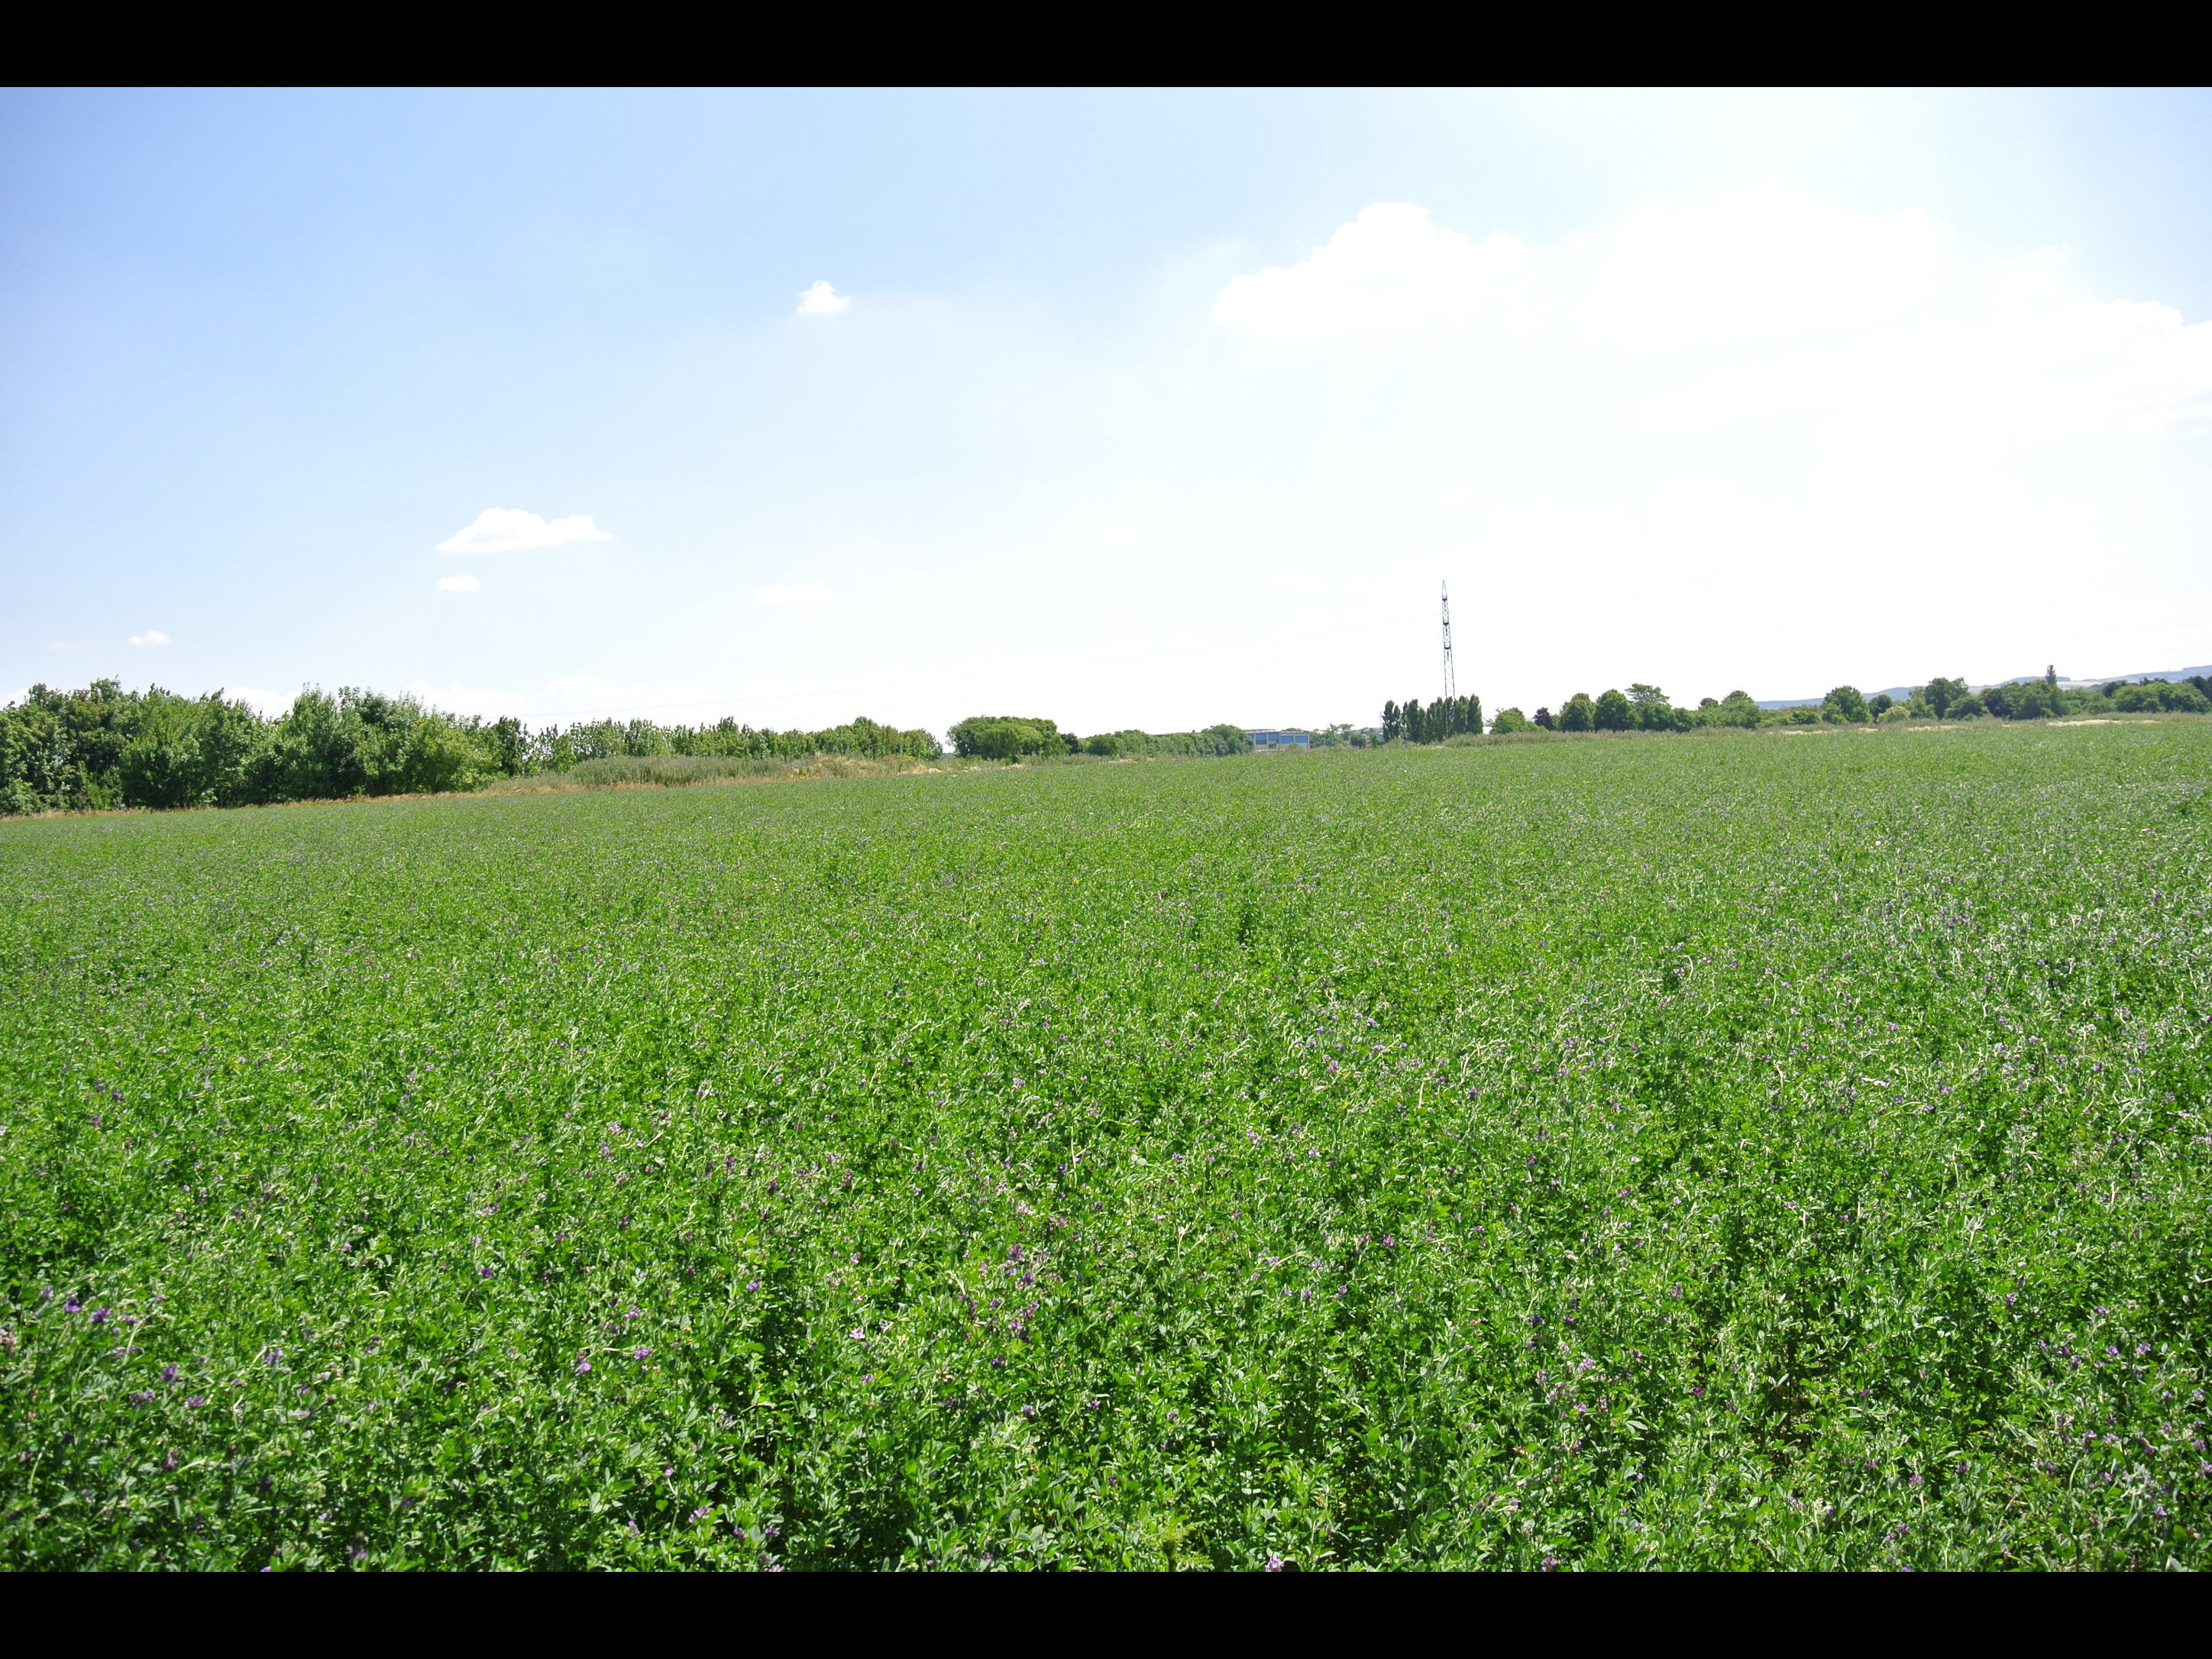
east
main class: Cropland
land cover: Lucerne
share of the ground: > 75 %
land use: Agriculture (excluding fallow land and kitchen gardens)
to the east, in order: Lucerne; Grass margins; Paved roads, cycling and walking lanes; Grass margins; Spontaneously vegetated surfaces; Temporary grasslands; Tracks; Broadleaved woodland; Grass margins; Paved roads, cycling and walking lanes; Grass margins
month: June
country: AT
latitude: 47.7982
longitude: 16.4796
